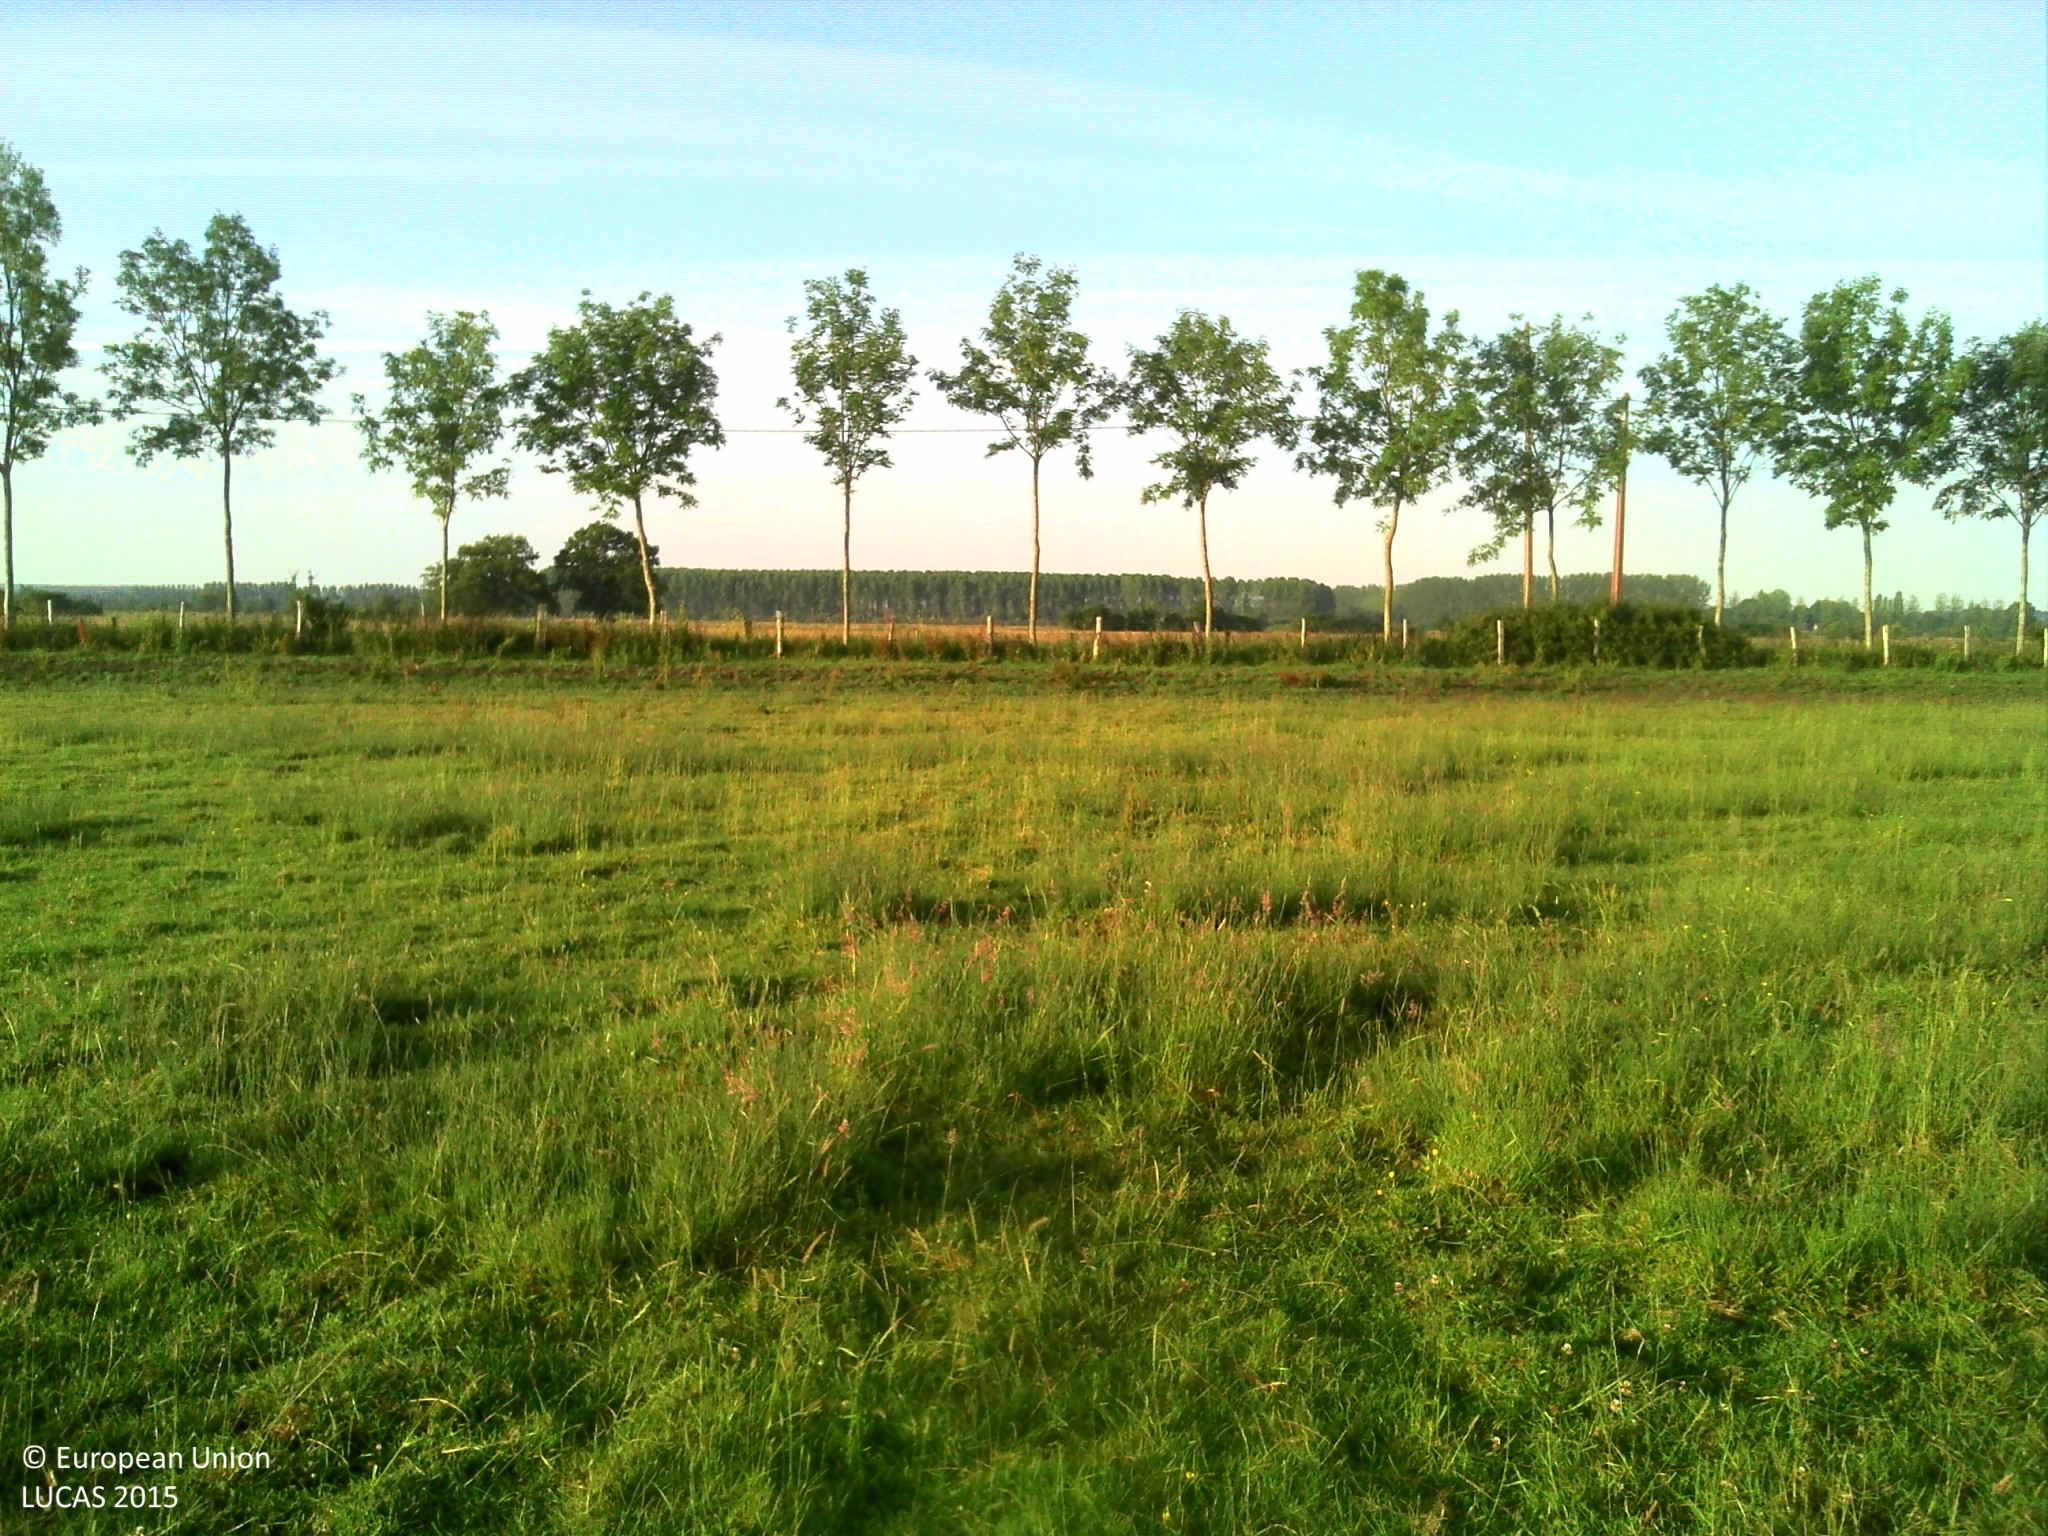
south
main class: Grassland
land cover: Grassland without tree/shrub cover
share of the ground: > 75 %
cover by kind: herbaceous plants 100 %
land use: Agriculture (excluding fallow land and kitchen gardens)
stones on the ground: < 10 %
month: June
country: FR
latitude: 49.1254
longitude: -0.0209
